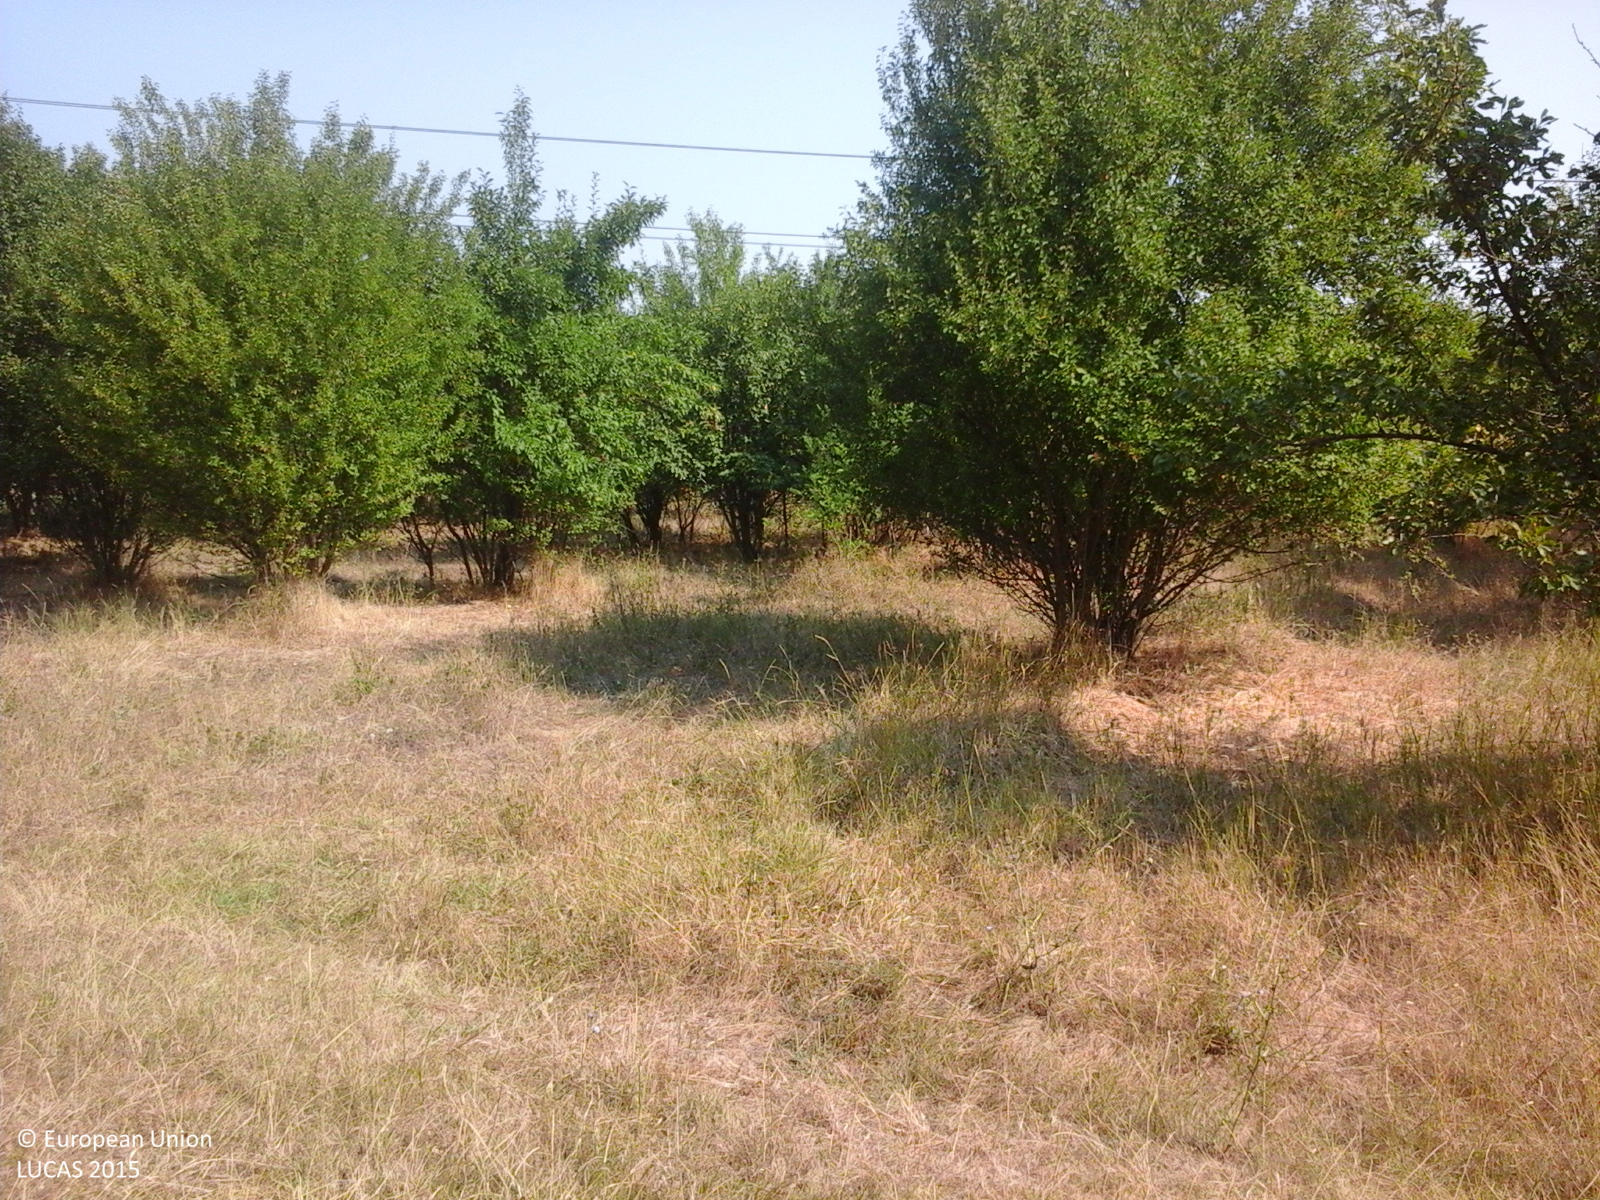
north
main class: Woodland
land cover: Broadleaved woodland
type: exotic forest
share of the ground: > 75 %
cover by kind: broadleaved forest trees 100 %
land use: Forestry
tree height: > 5 m
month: July
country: RO
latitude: 45.5987
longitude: 27.5794
